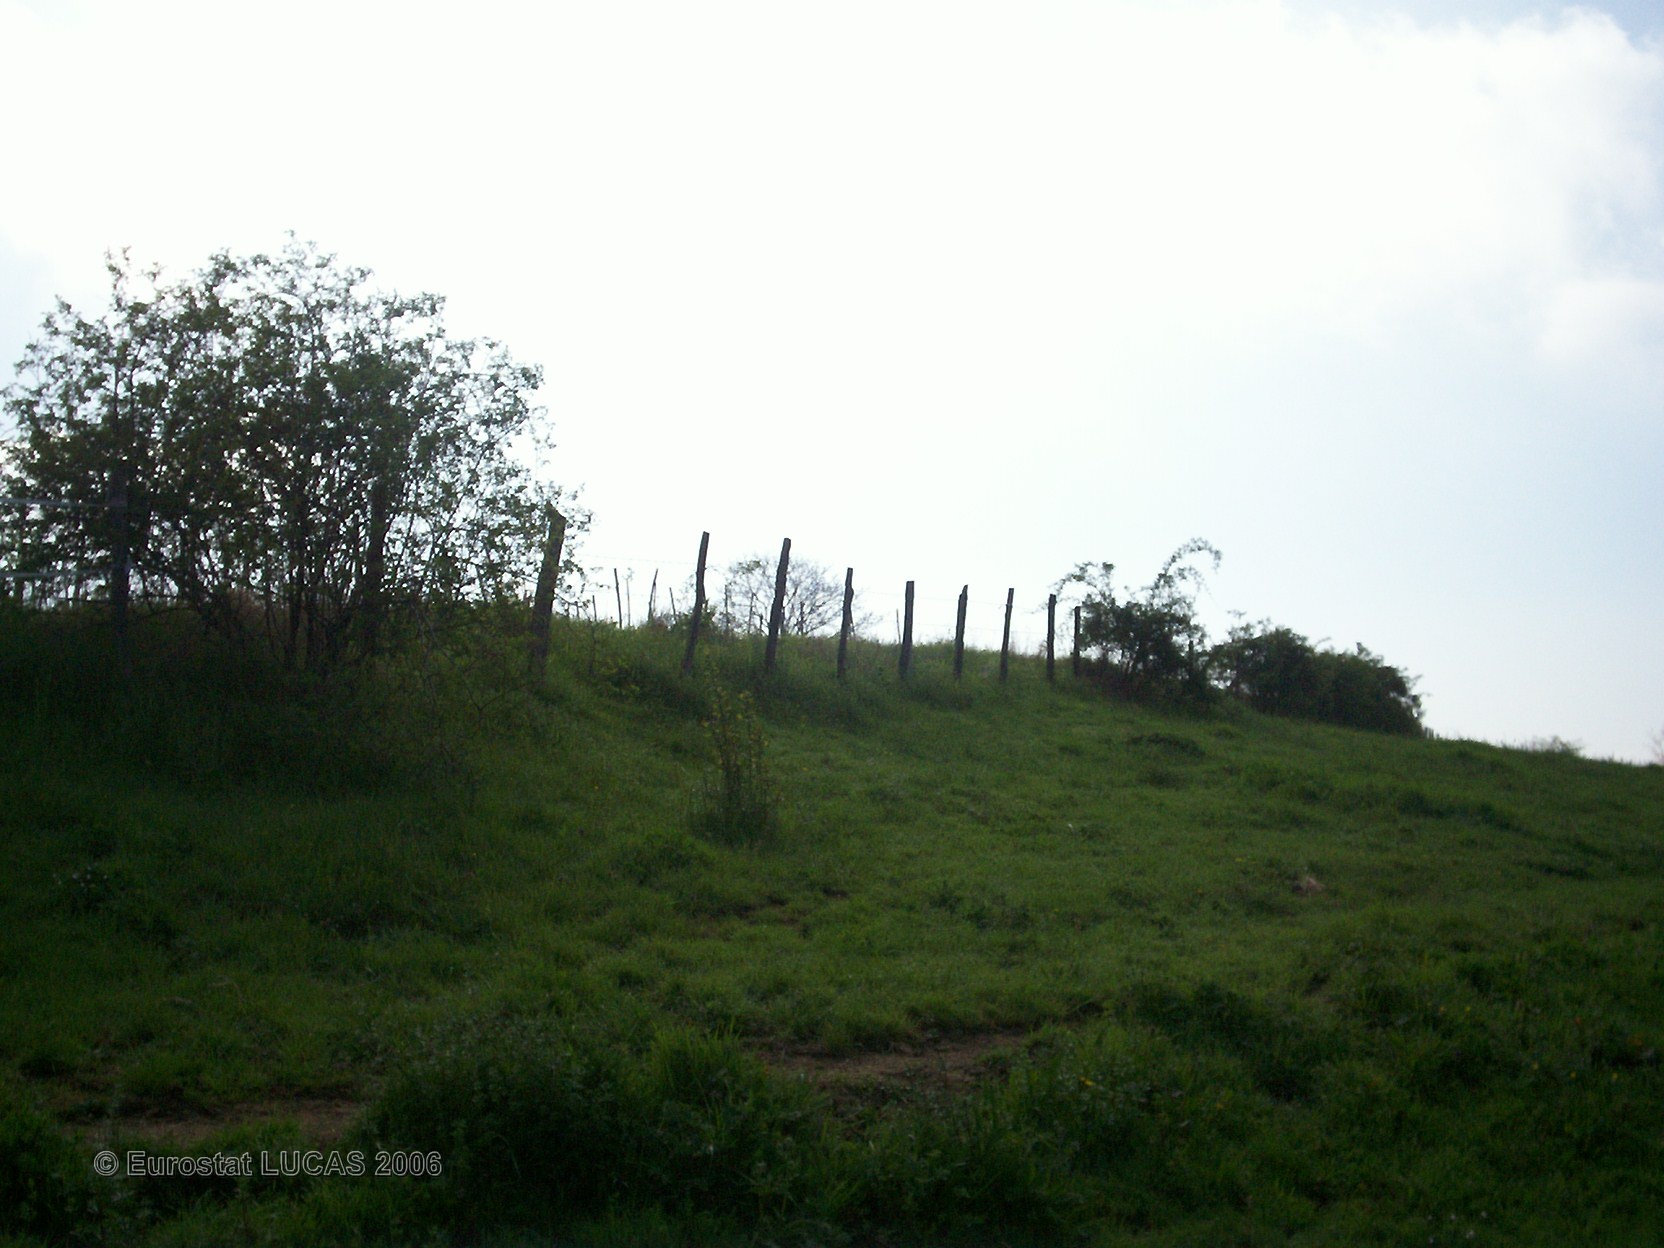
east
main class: Grassland
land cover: Grassland with sparse tree/shrub cover
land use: Agriculture (excluding fallow land and kitchen gardens)
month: April
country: FR
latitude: 45.5025
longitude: 4.7953
